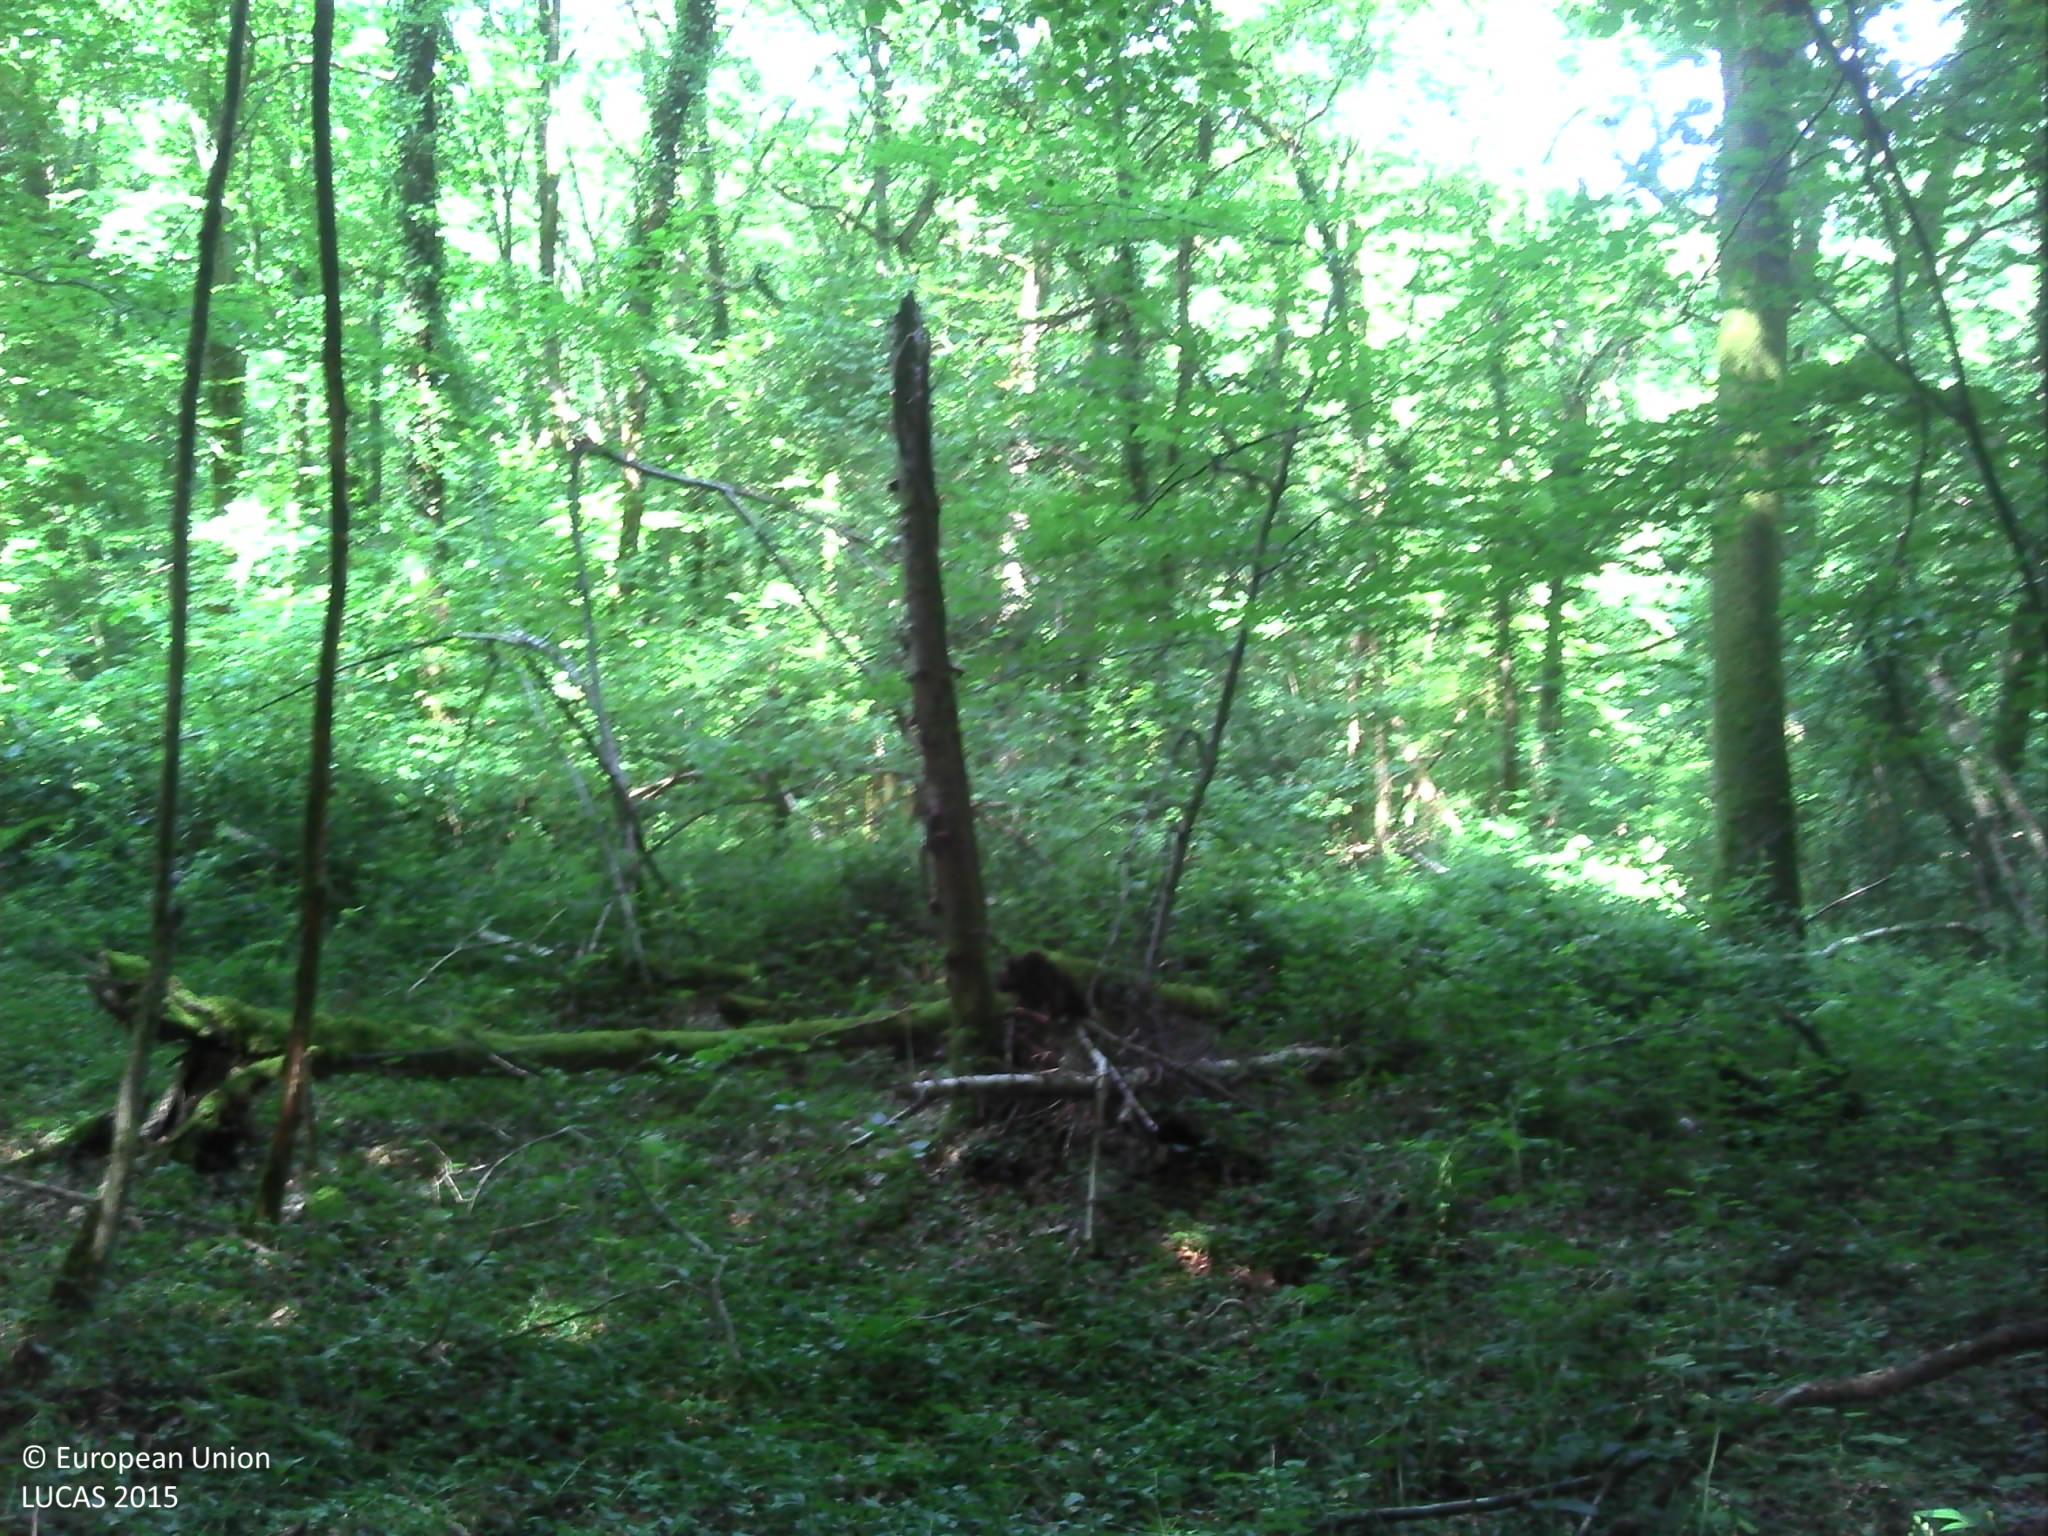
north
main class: Woodland
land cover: Broadleaved woodland
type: mesophytic deciduous forest
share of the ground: > 75 %
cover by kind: broadleaved forest trees 80 %, herbaceous plants 10 %, lichens and mosses 5 %, consolidated bare surface 5 %
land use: Forestry
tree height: > 5 m
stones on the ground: < 10 %
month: June
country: FR
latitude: 49.0930
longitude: 1.0913
